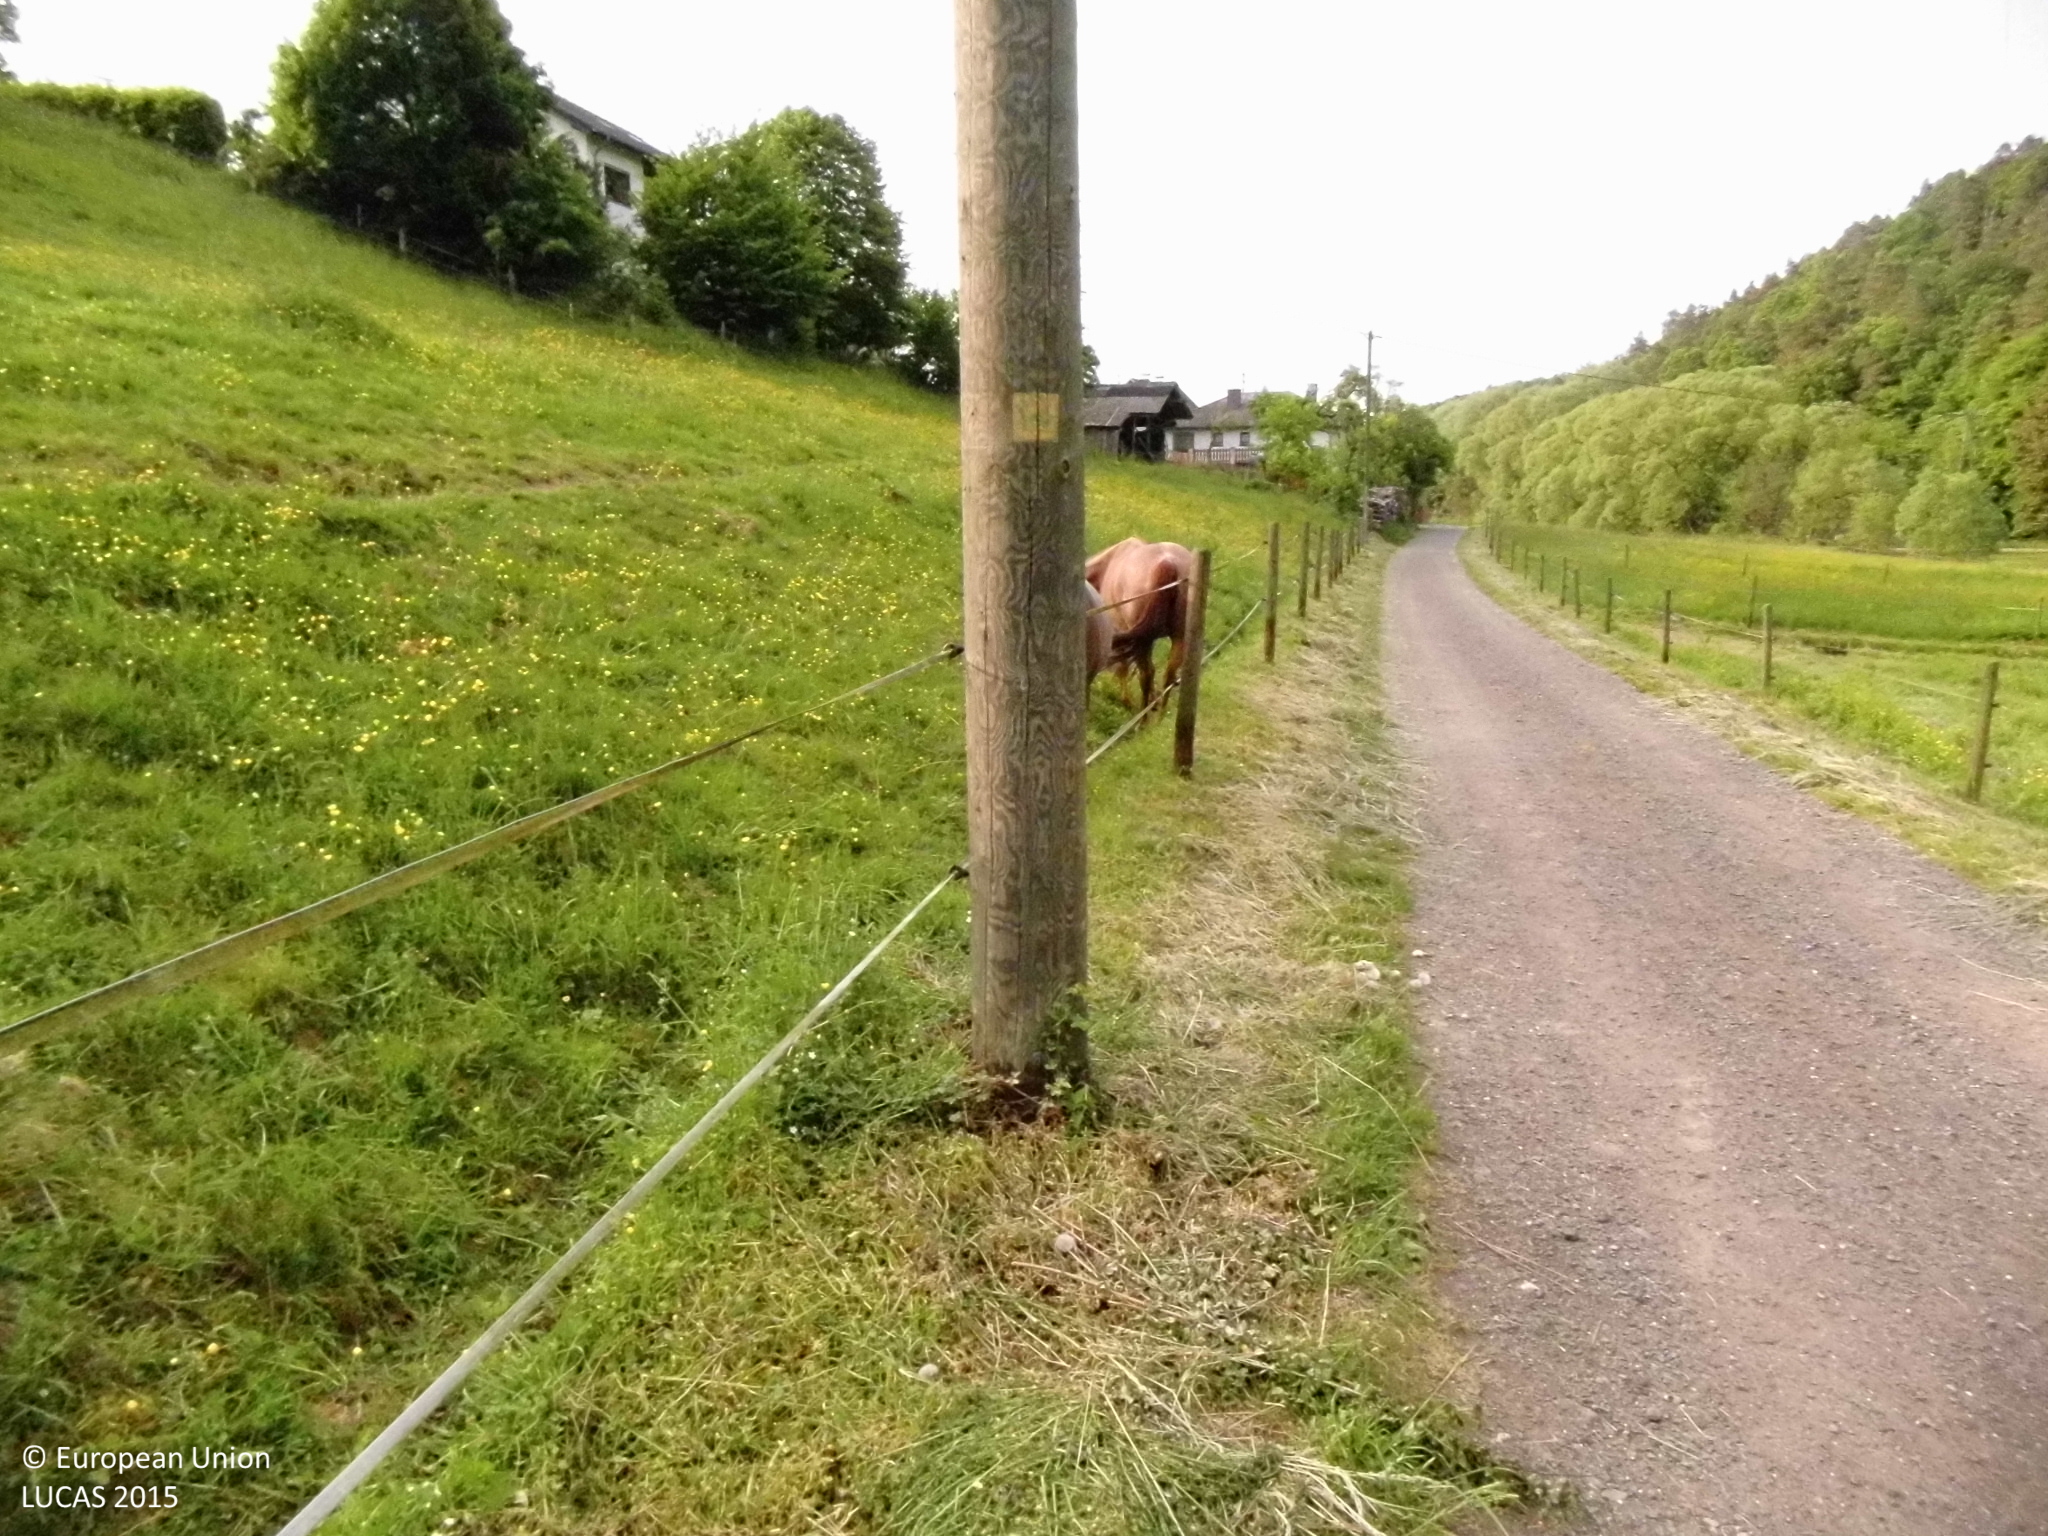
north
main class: Grassland
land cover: Grassland without tree/shrub cover
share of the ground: > 75 %
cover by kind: herbaceous plants 100 %
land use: Agriculture (excluding fallow land and kitchen gardens)
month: May
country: DE
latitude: 50.5886
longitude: 7.5001
